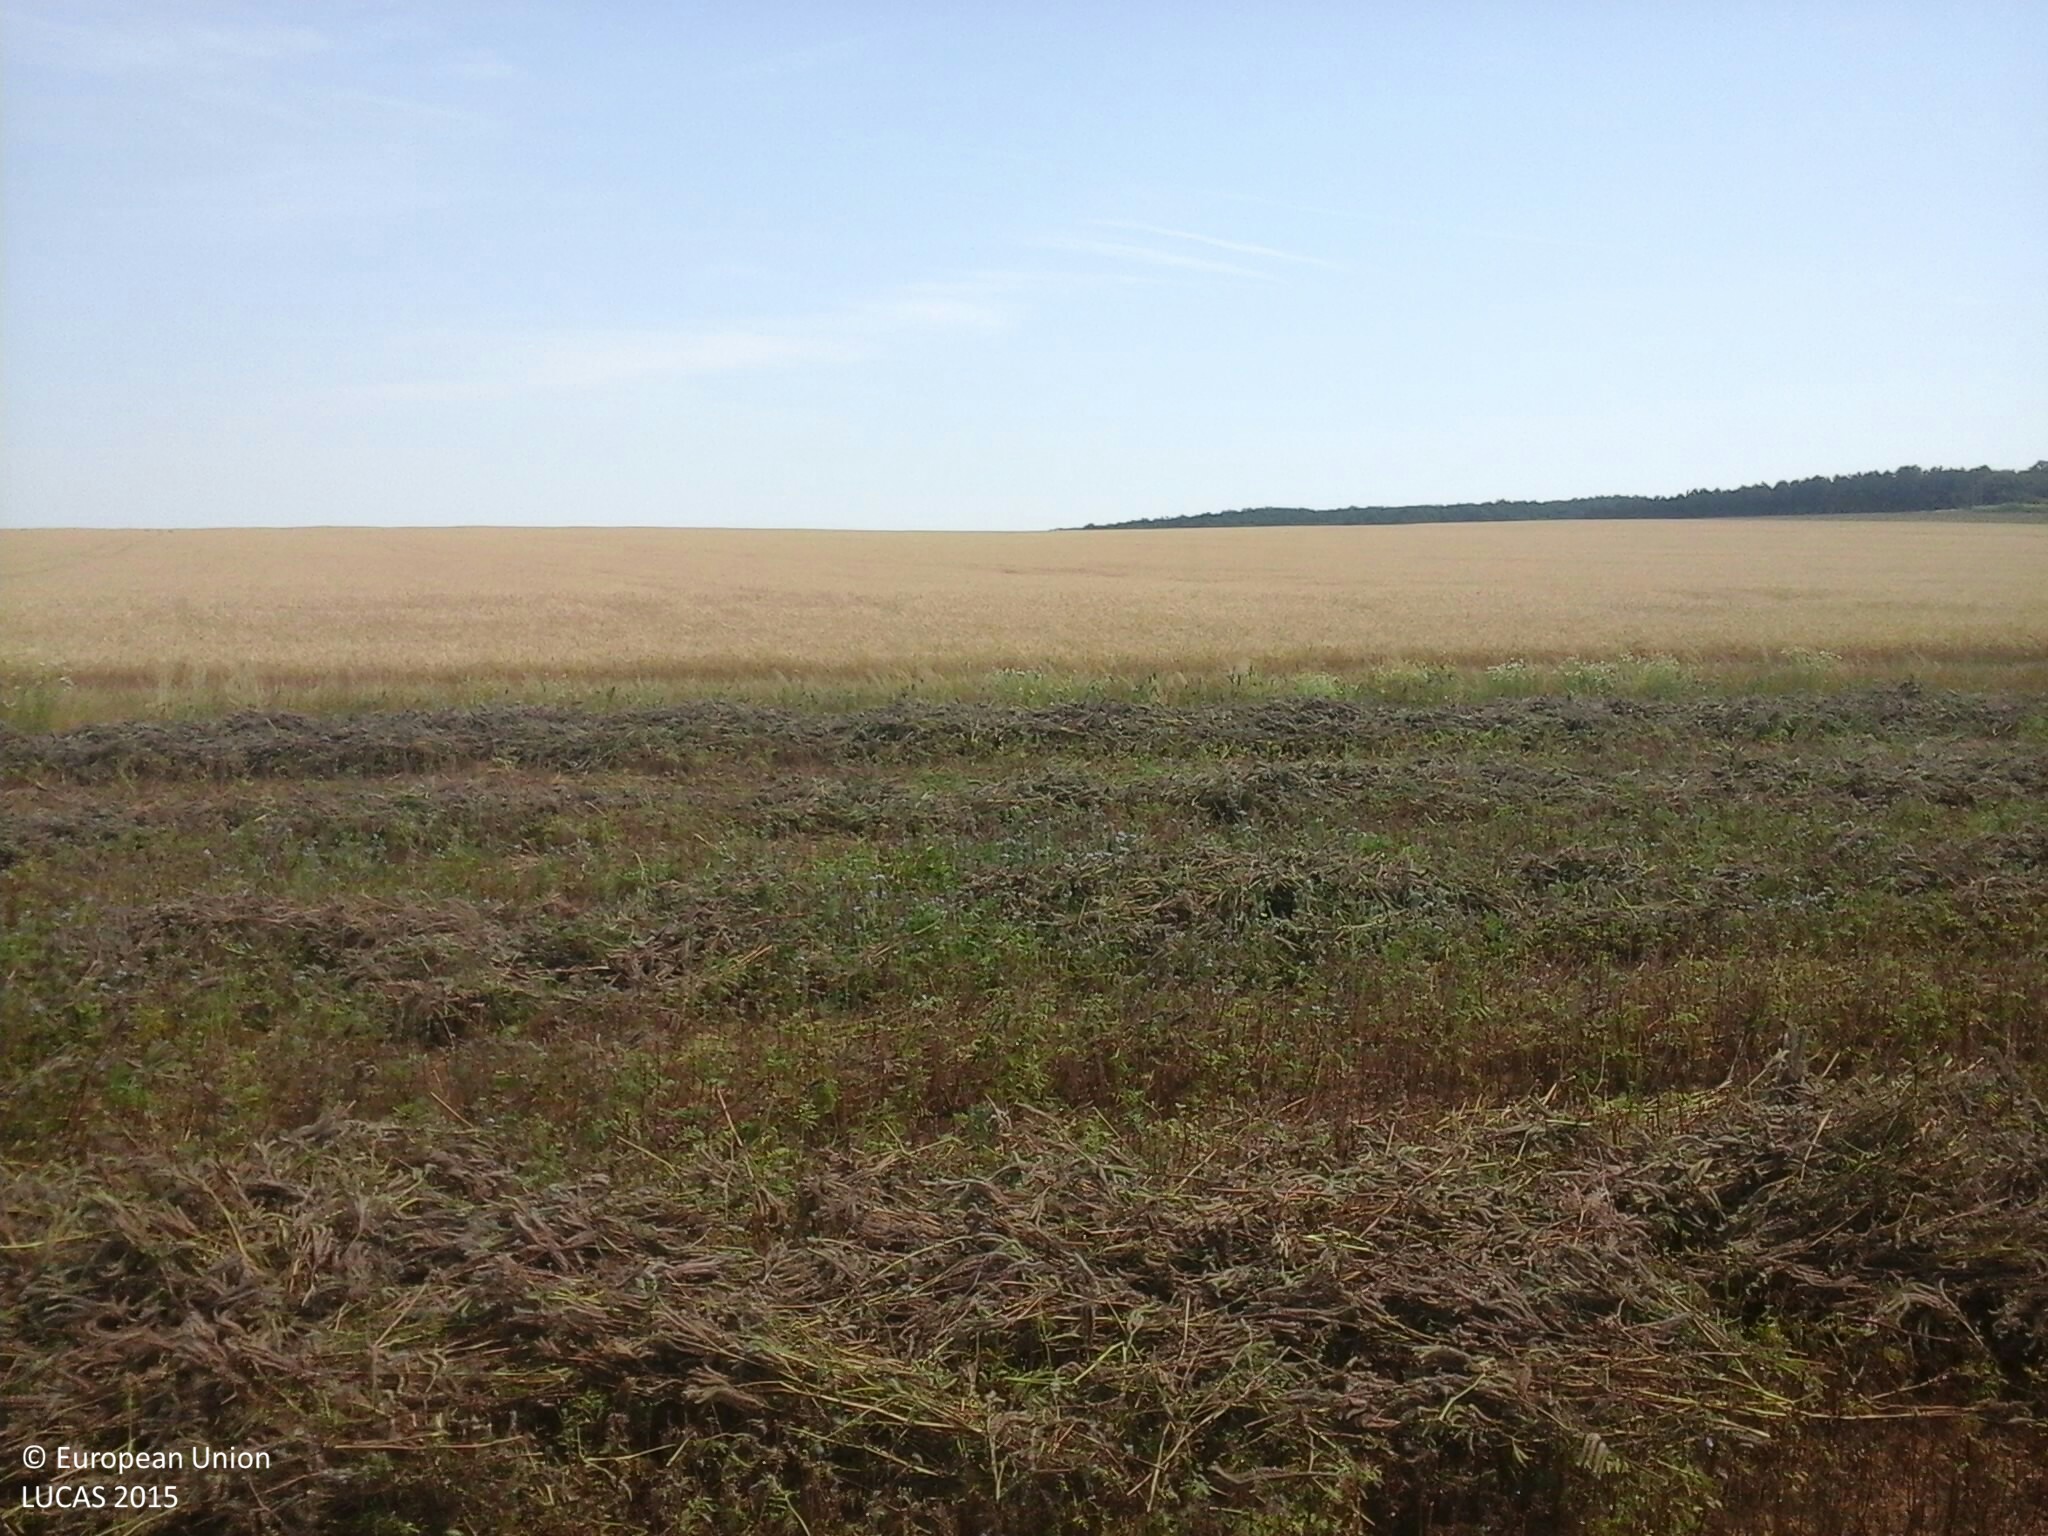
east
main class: Cropland
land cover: Other leguminous and mixtures for fodder
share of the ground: > 75 %
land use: Agriculture (excluding fallow land and kitchen gardens)
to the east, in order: Other leguminous and mixtures for fodder; Ditches and canals; Tracks; Grass margins; Common wheat
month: July
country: HU
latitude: 47.0401
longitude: 17.8392
